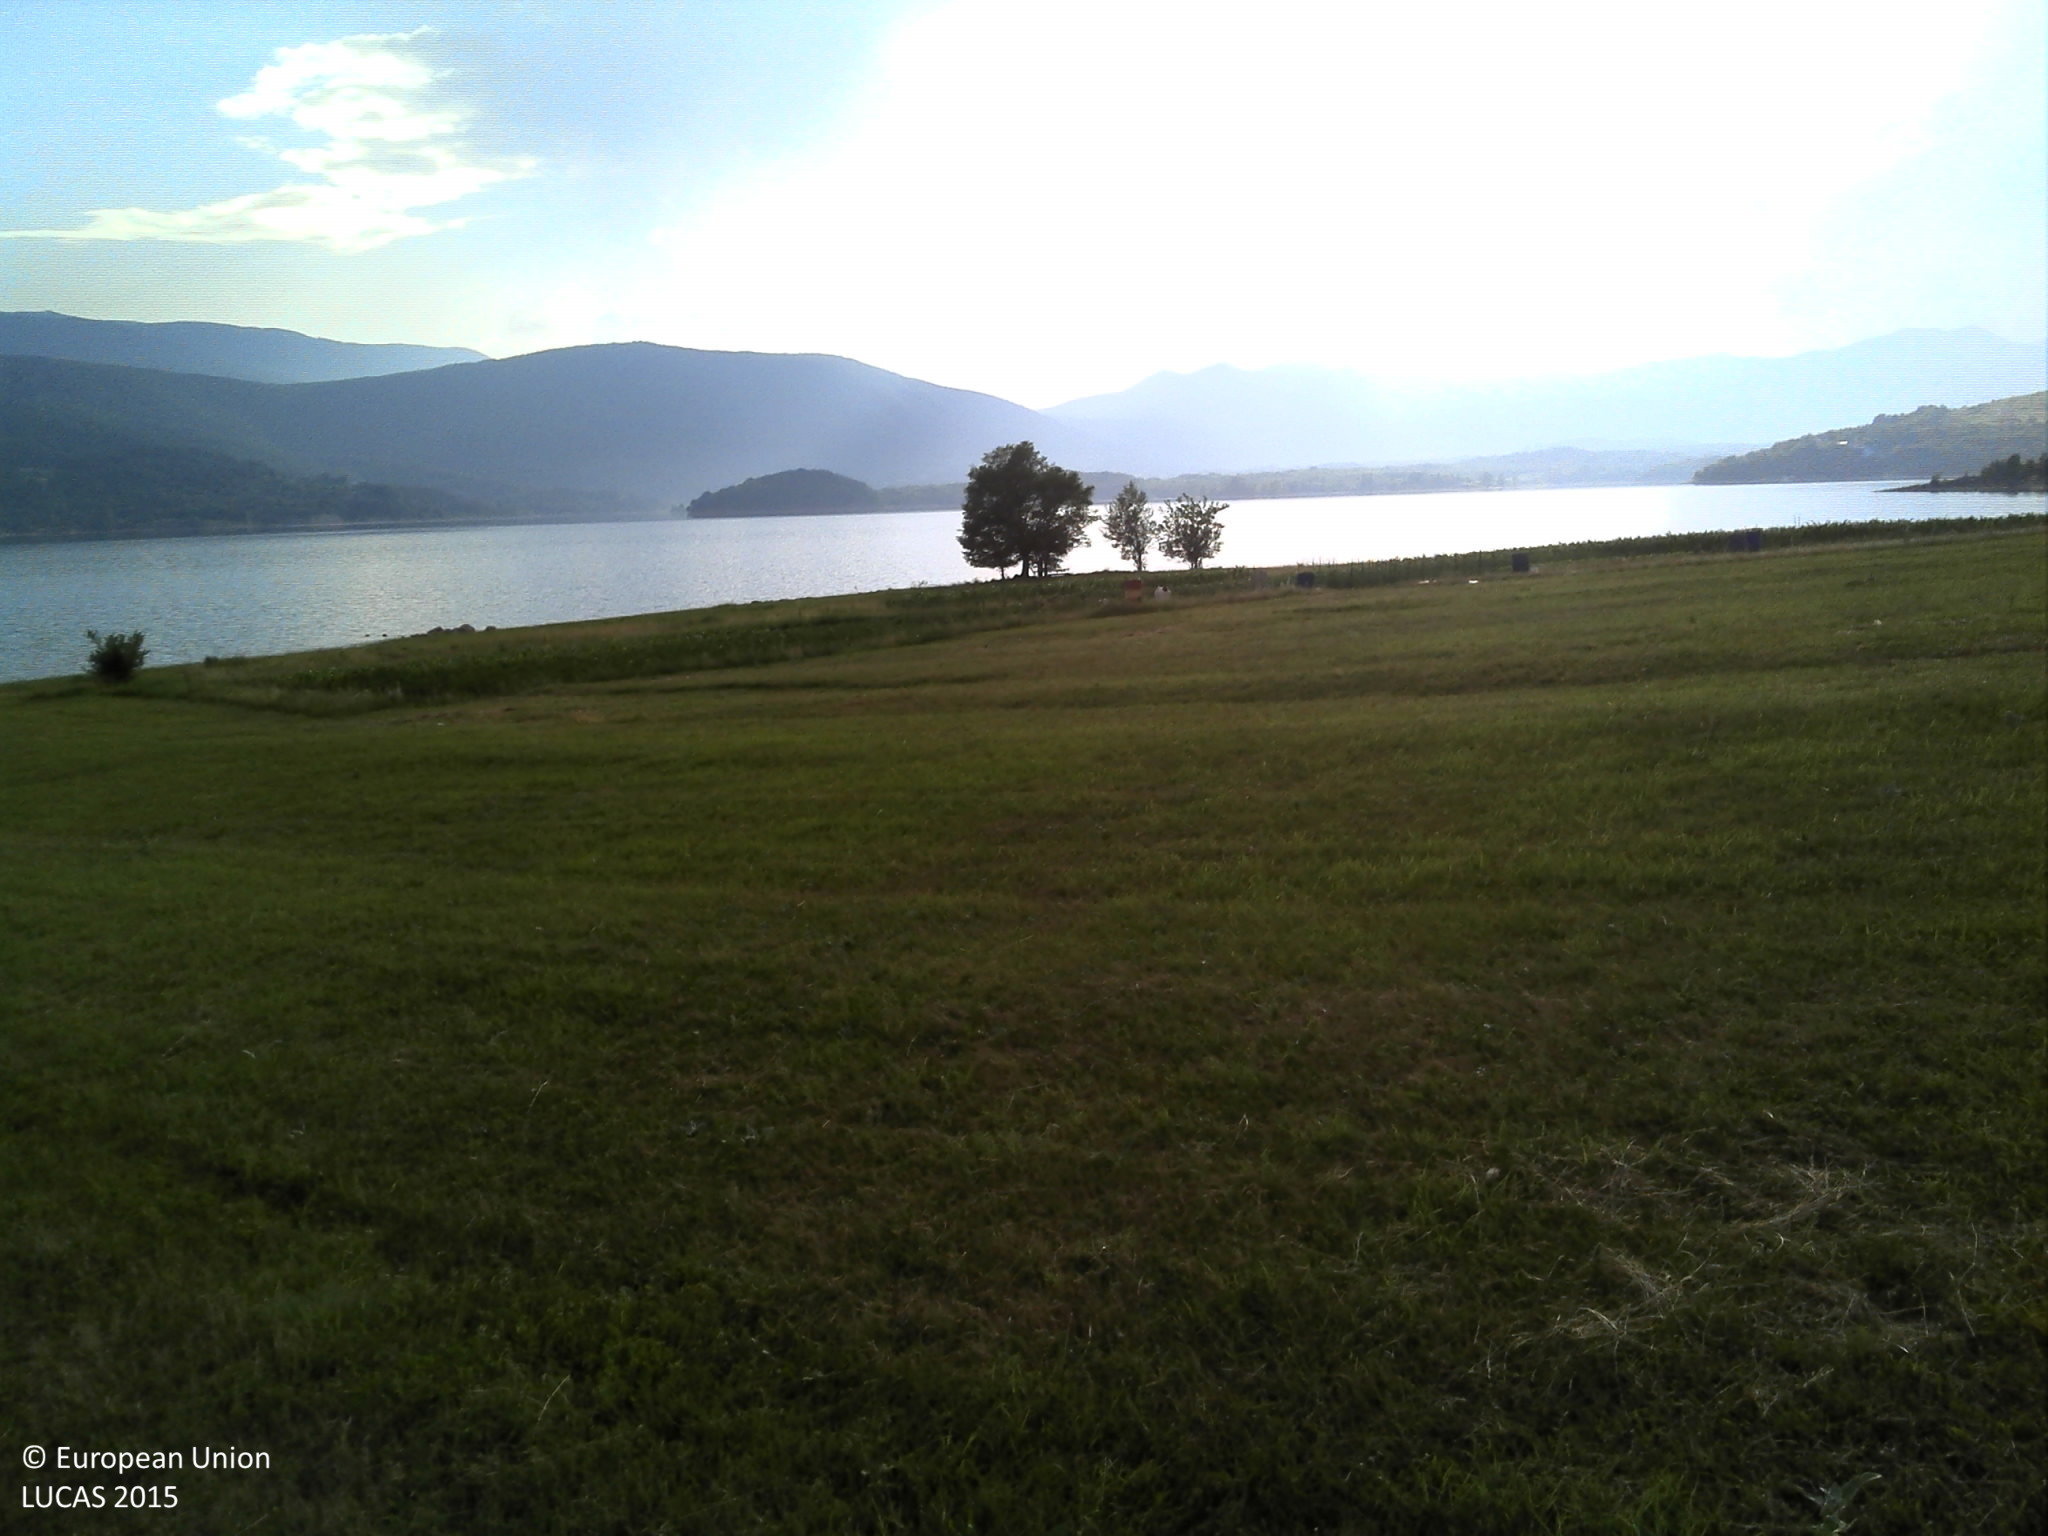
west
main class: Grassland
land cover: Grassland with sparse tree/shrub cover
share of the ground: > 75 %
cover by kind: herbaceous plants 90 %, broadleaved forest trees 5 %, shrubs 5 %
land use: Agriculture (excluding fallow land and kitchen gardens)
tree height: < 5 m
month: June
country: HR
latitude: 43.8948
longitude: 16.4783
